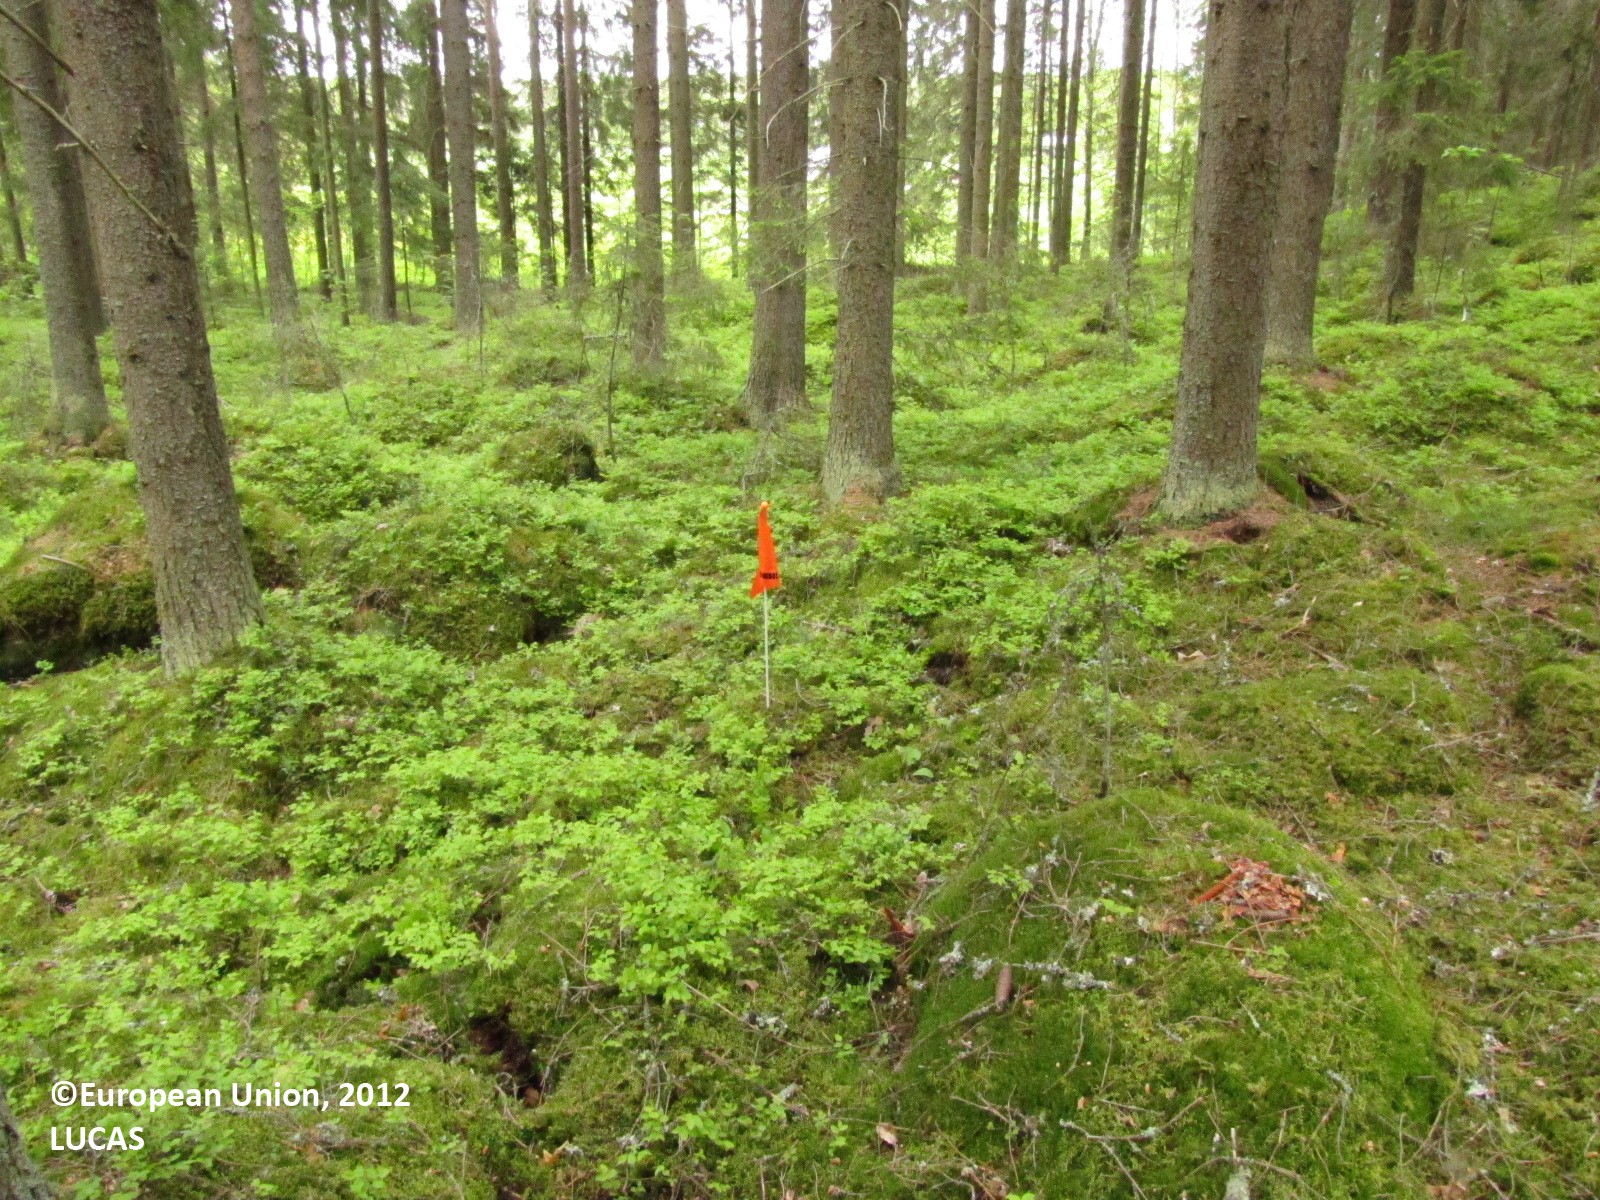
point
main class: Woodland
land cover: Spruce dominated coniferous woodland
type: hemiboreal forest and nemoral coniferous forest and mixed broadleaved-coniferous forest
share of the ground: > 75 %
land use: Forestry
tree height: > 5 m
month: June
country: FI
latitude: 61.6155
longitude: 23.1017
